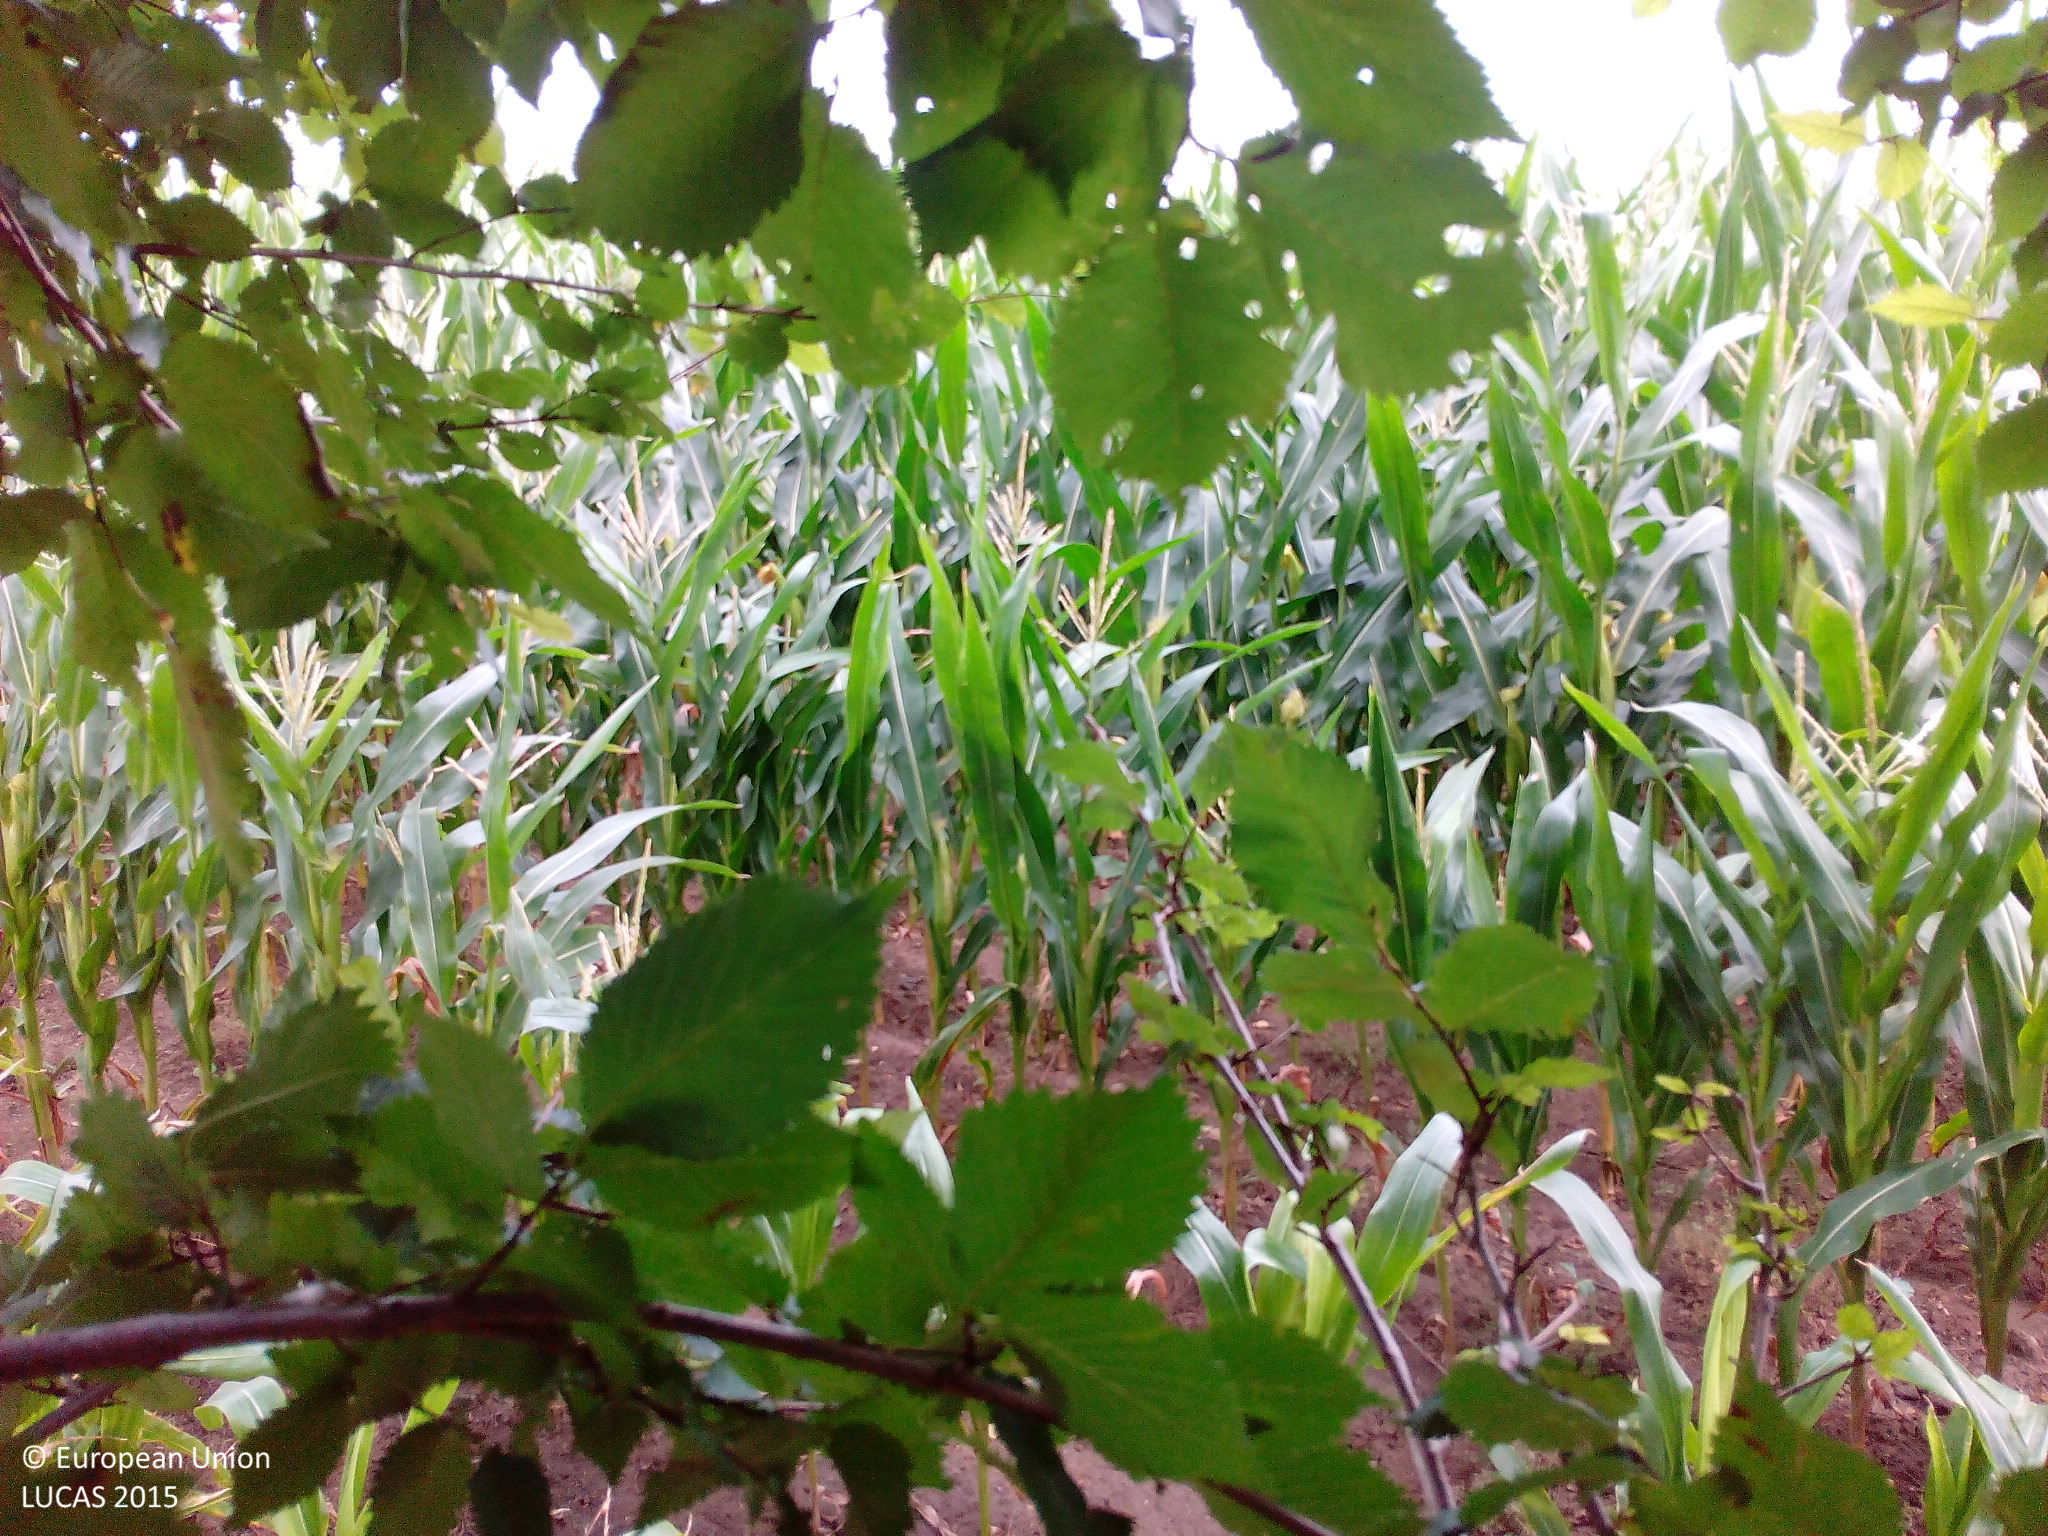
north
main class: Woodland
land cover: Broadleaved woodland
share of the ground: 50 - 75 %
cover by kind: herbaceous plants 80 %, broadleaved forest trees 10 %, unconsolidated bare surface 10 %
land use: Semi-natural and natural areas not in use
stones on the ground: < 10 %
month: August
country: DE
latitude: 53.9135
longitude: 12.6025
